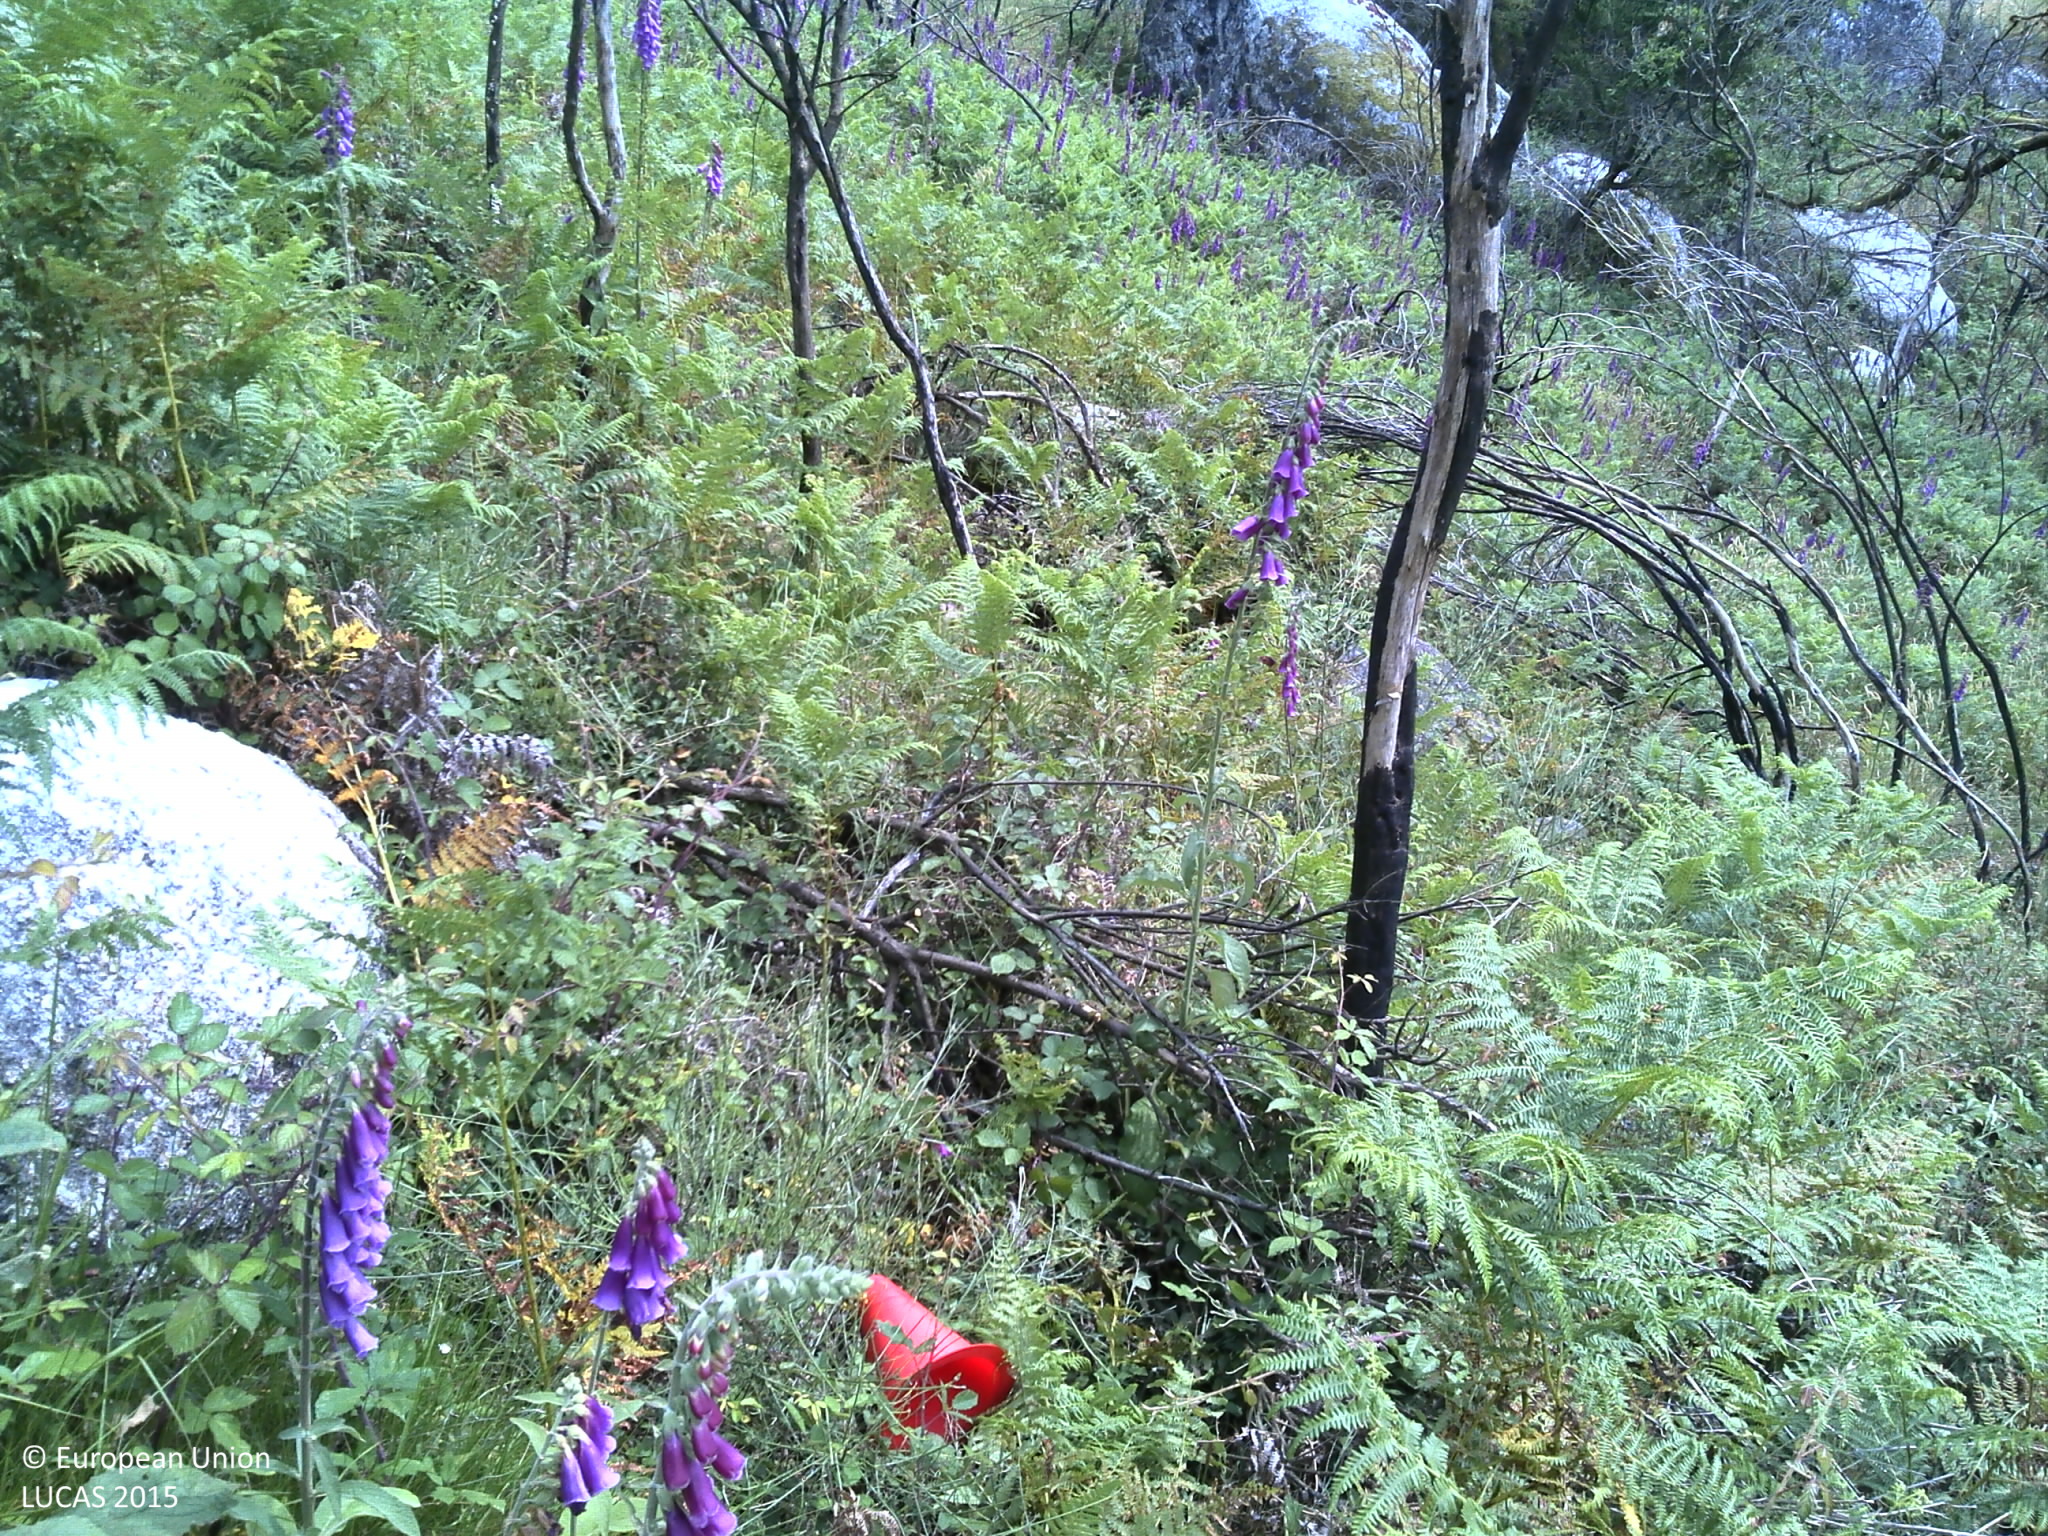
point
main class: Shrubland
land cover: Shrubland without tree cover
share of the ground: 50 - 75 %
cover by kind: shrubs 70 %, herbaceous plants 15 %, consolidated bare surface 10 %, unconsolidated bare surface 5 %
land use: Agriculture (excluding fallow land and kitchen gardens)
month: June
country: PT
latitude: 41.7677
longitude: -8.3802
